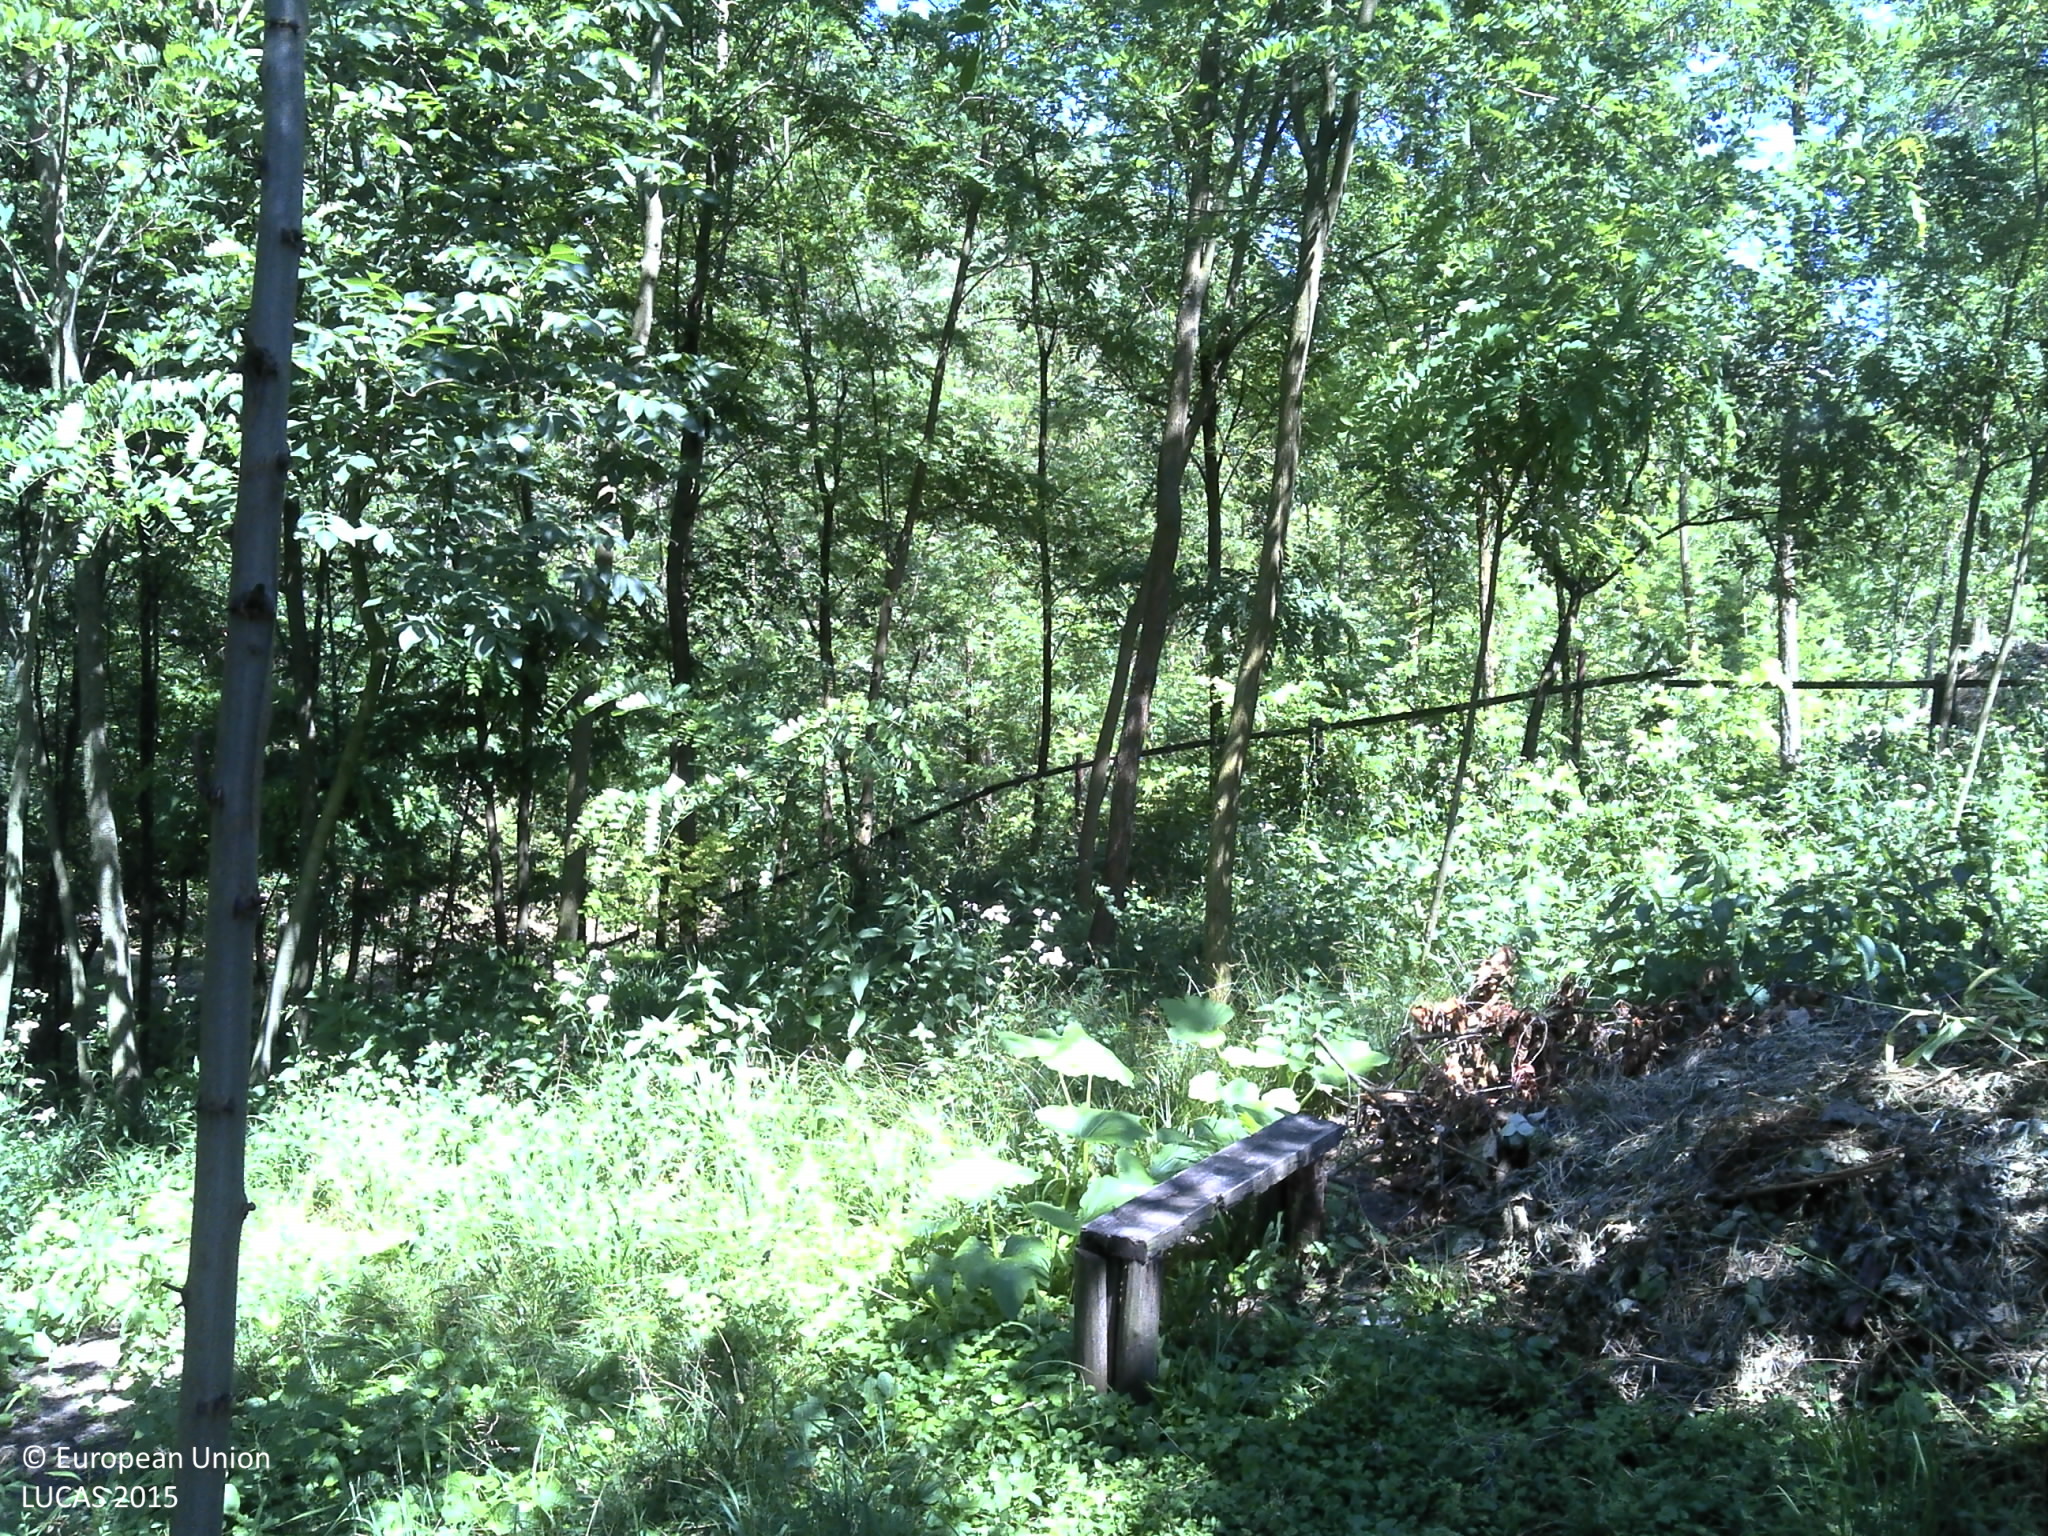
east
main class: Grassland
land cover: Grassland with sparse tree/shrub cover
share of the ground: > 75 %
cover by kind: herbaceous plants 95 %, broadleaved forest trees 5 %
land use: Semi-natural and natural areas not in use
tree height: < 5 m
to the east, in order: Grassland with sparse tree/shrub cover; Fences; Ditches and canals; Shrubland with sparse tree cover; Broadleaved woodland
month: June
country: HR
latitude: 45.7429
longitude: 18.2447
